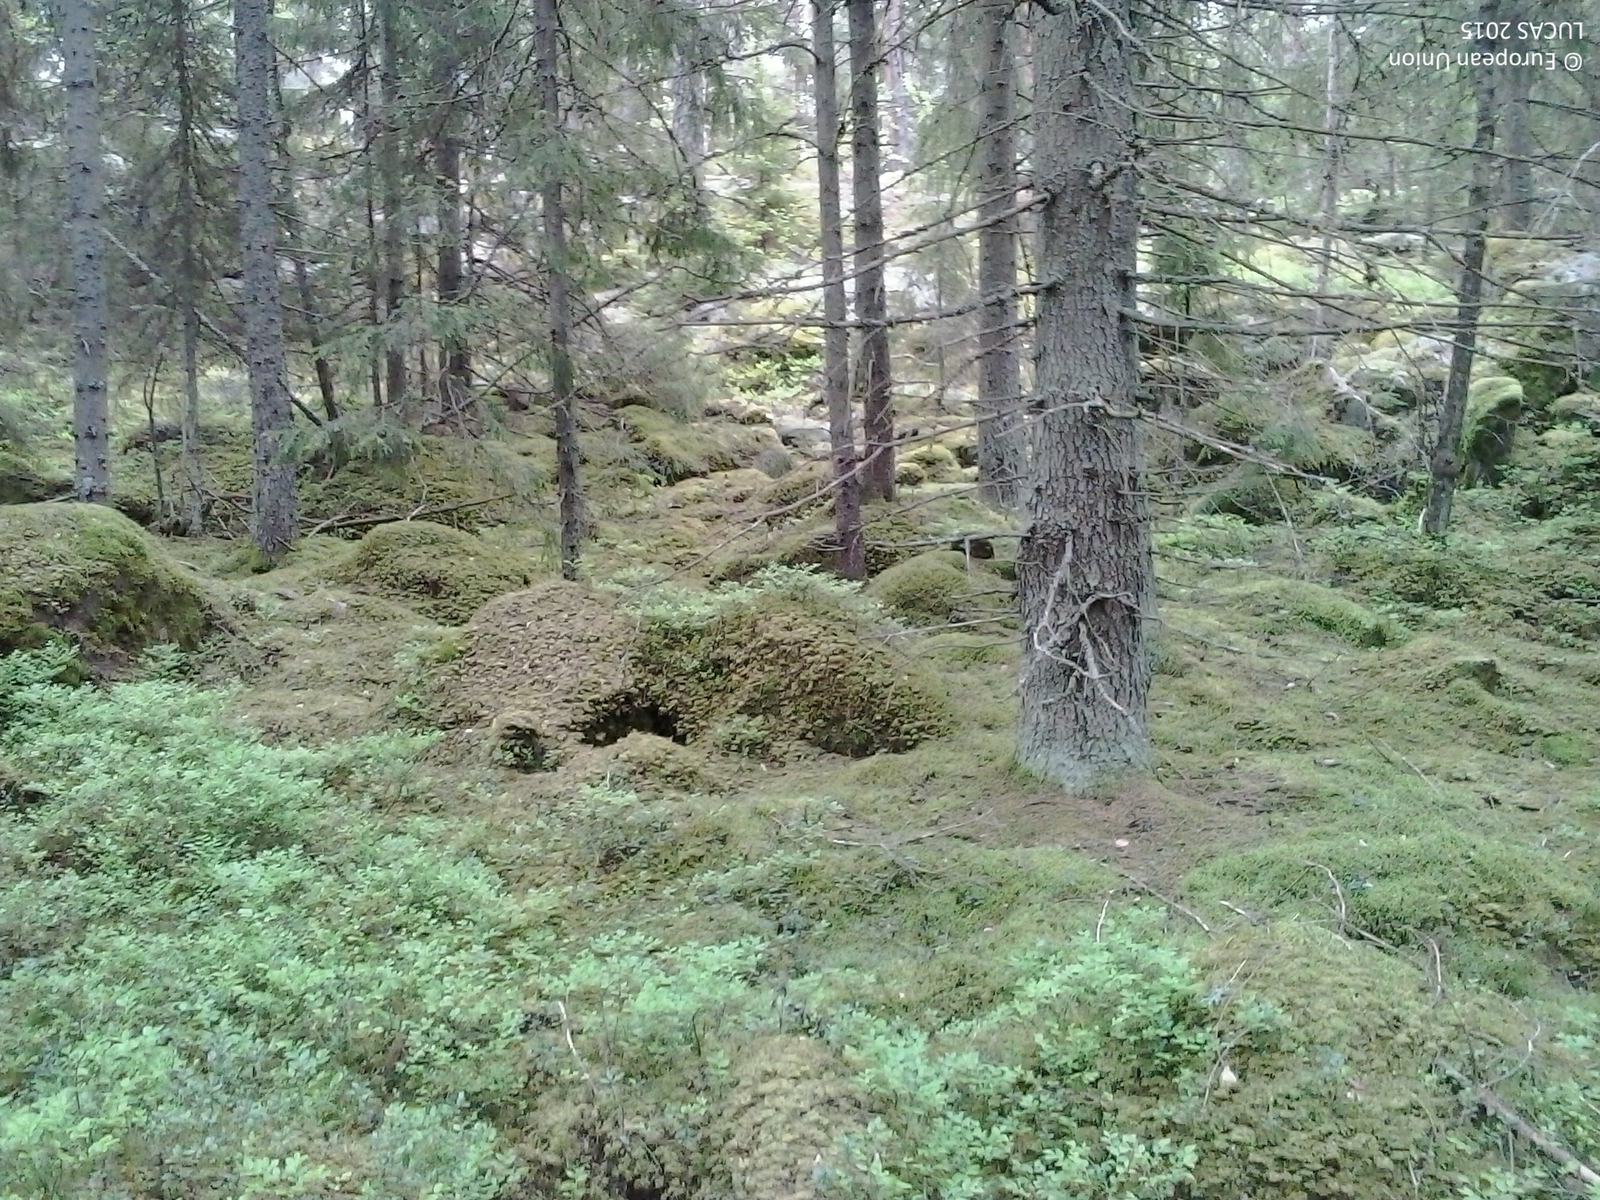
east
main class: Woodland
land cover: Spruce dominated coniferous woodland
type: boreal forest
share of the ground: 50 - 75 %
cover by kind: coniferous forest trees 55 %, broadleaved forest trees 15 %, shrubs 10 %, herbaceous plants 10 %, lichens and mosses 10 %
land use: Forestry
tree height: > 5 m
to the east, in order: Spruce dominated coniferous woodland; Other mixed woodland; Pine dominated coniferous woodland; Other coniferous woodland; Ditches and canals; Paved roads, cycling and walking lanes; Spruce dominated coniferous woodland; Spruce dominated mixed woodland; Rivers and streams; Spruce dominated mixed woodland; Other mixed woodland
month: June
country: SE
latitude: 59.3644
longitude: 14.0909
